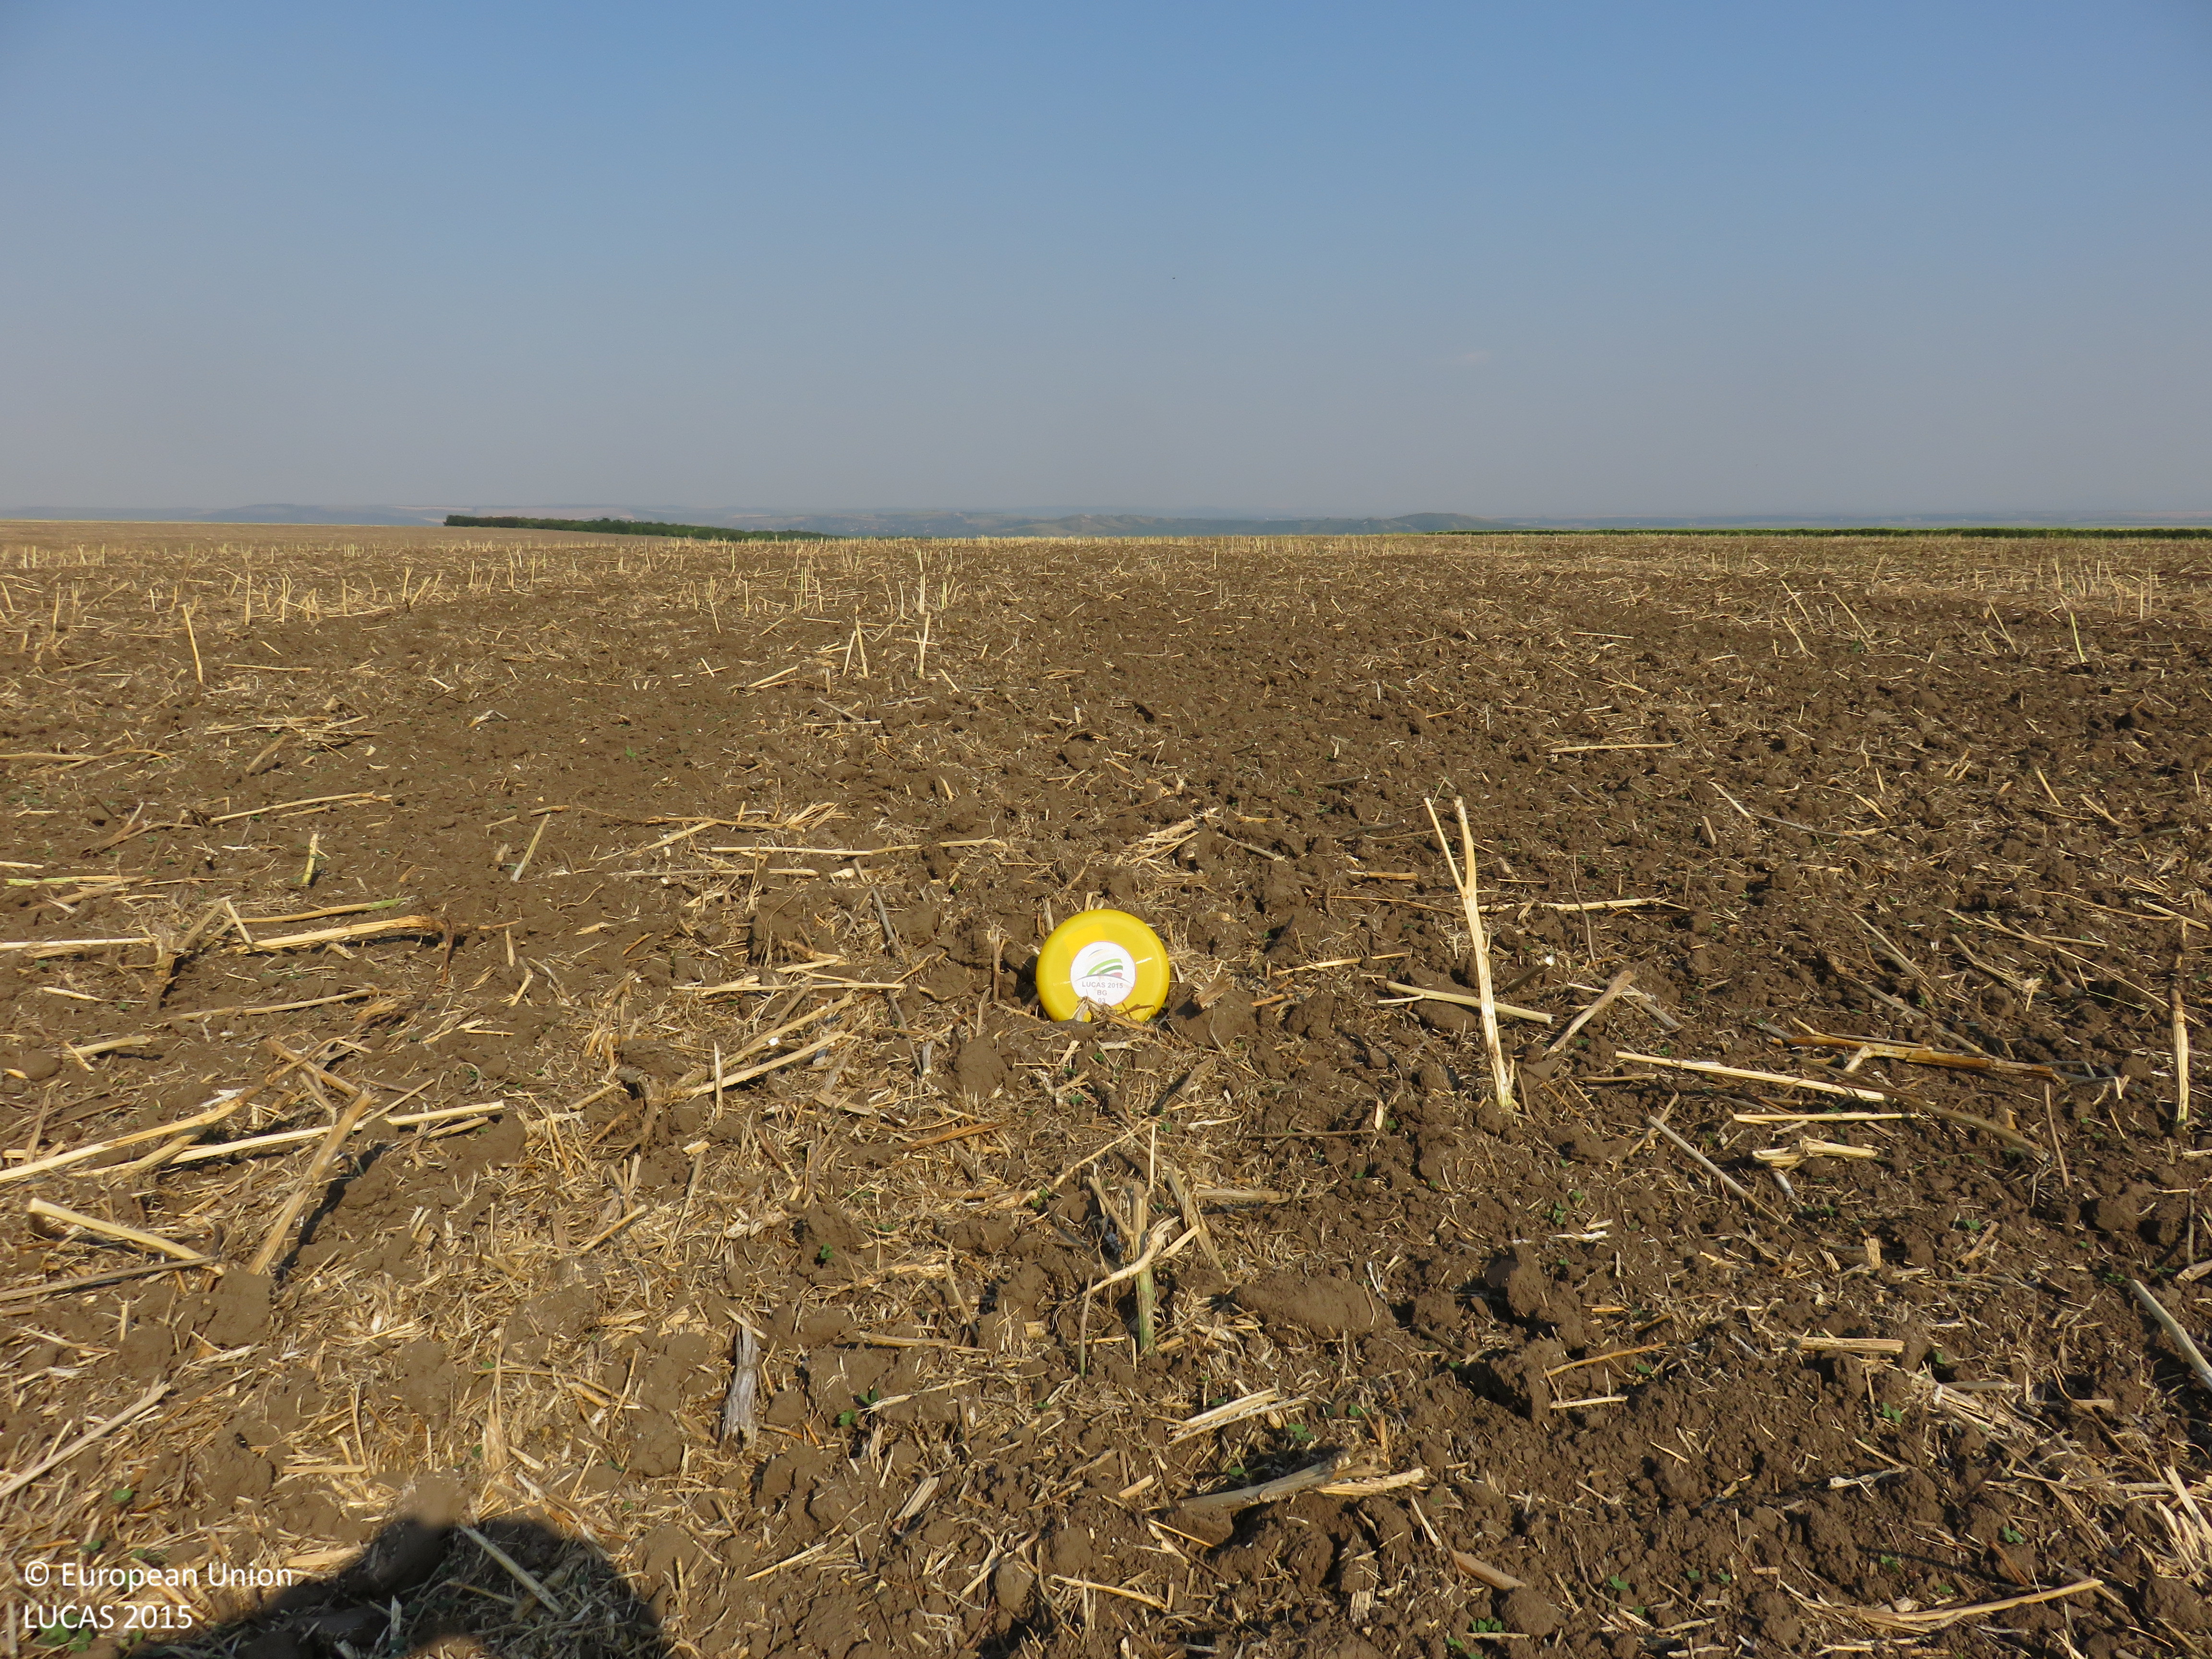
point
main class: Cropland
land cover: Rape and turnip rape
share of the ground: < 10 %
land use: Agriculture (excluding fallow land and kitchen gardens)
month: July
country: BG
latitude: 43.5059
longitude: 24.8993
